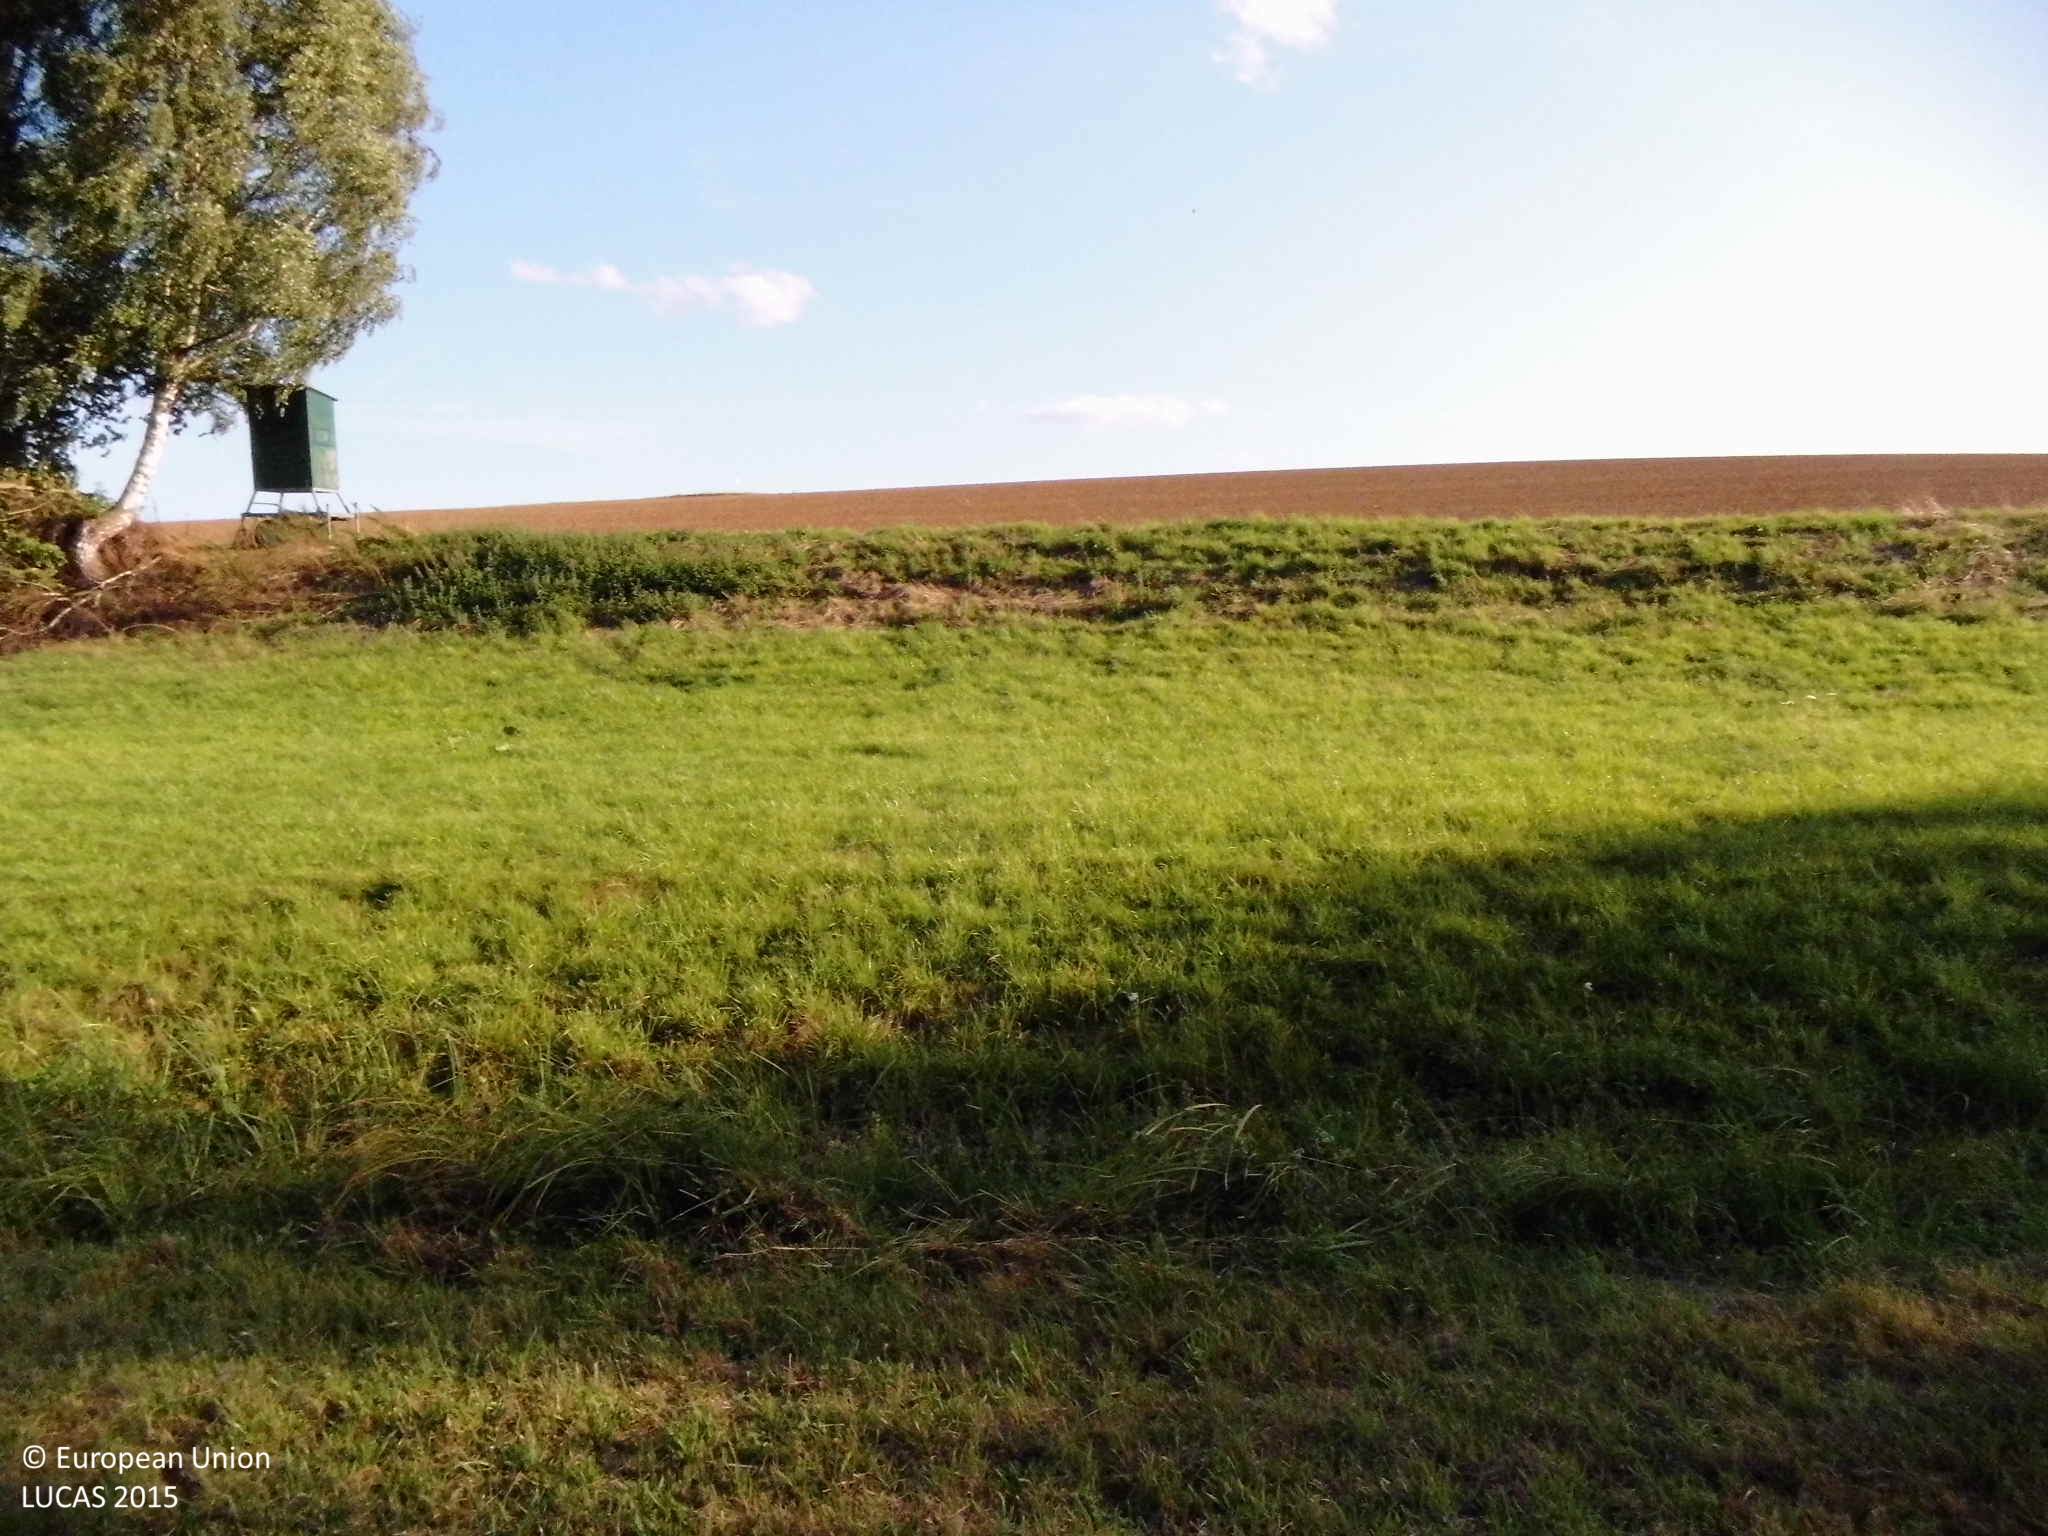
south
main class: Grassland
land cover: Grassland without tree/shrub cover
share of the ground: > 75 %
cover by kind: herbaceous plants 100 %
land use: Agriculture (excluding fallow land and kitchen gardens)
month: August
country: DE
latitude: 50.4008
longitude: 8.0167
